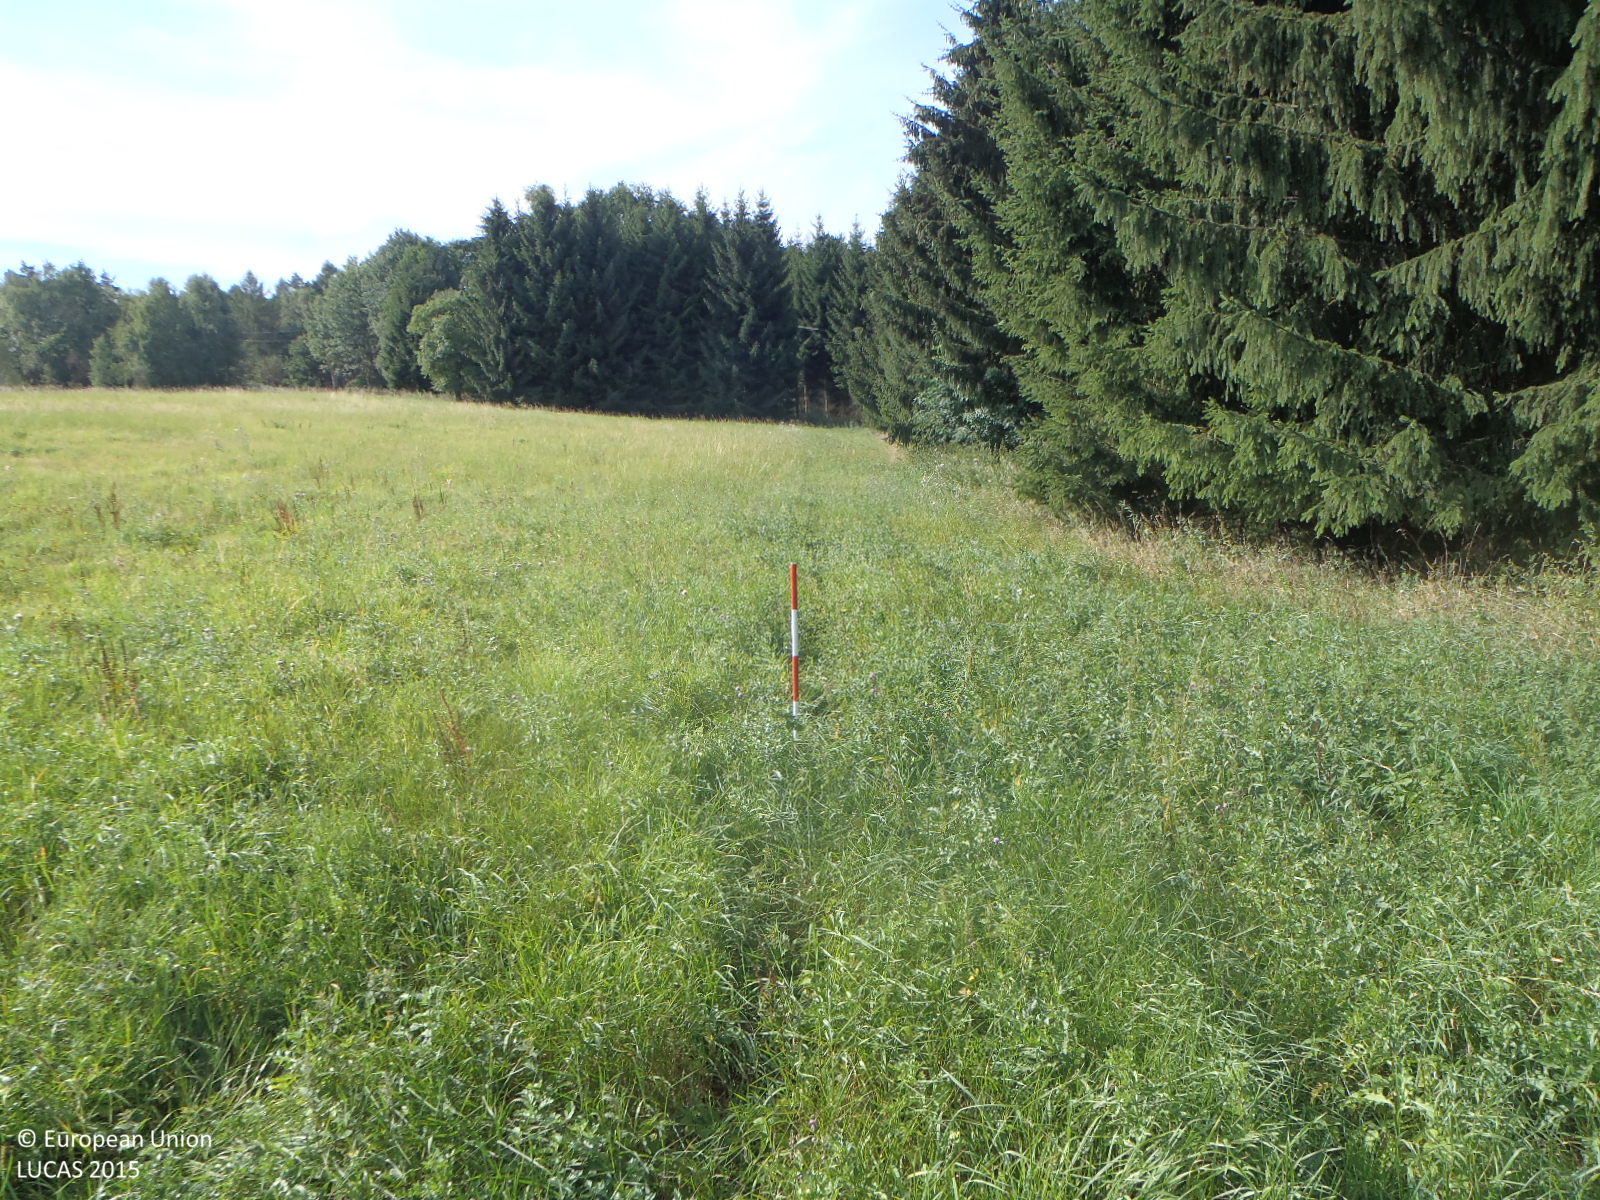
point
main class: Grassland
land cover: Grassland without tree/shrub cover
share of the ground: > 75 %
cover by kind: herbaceous plants 100 %
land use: Agriculture (excluding fallow land and kitchen gardens)
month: August
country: CZ
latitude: 50.9932
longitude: 15.0038
